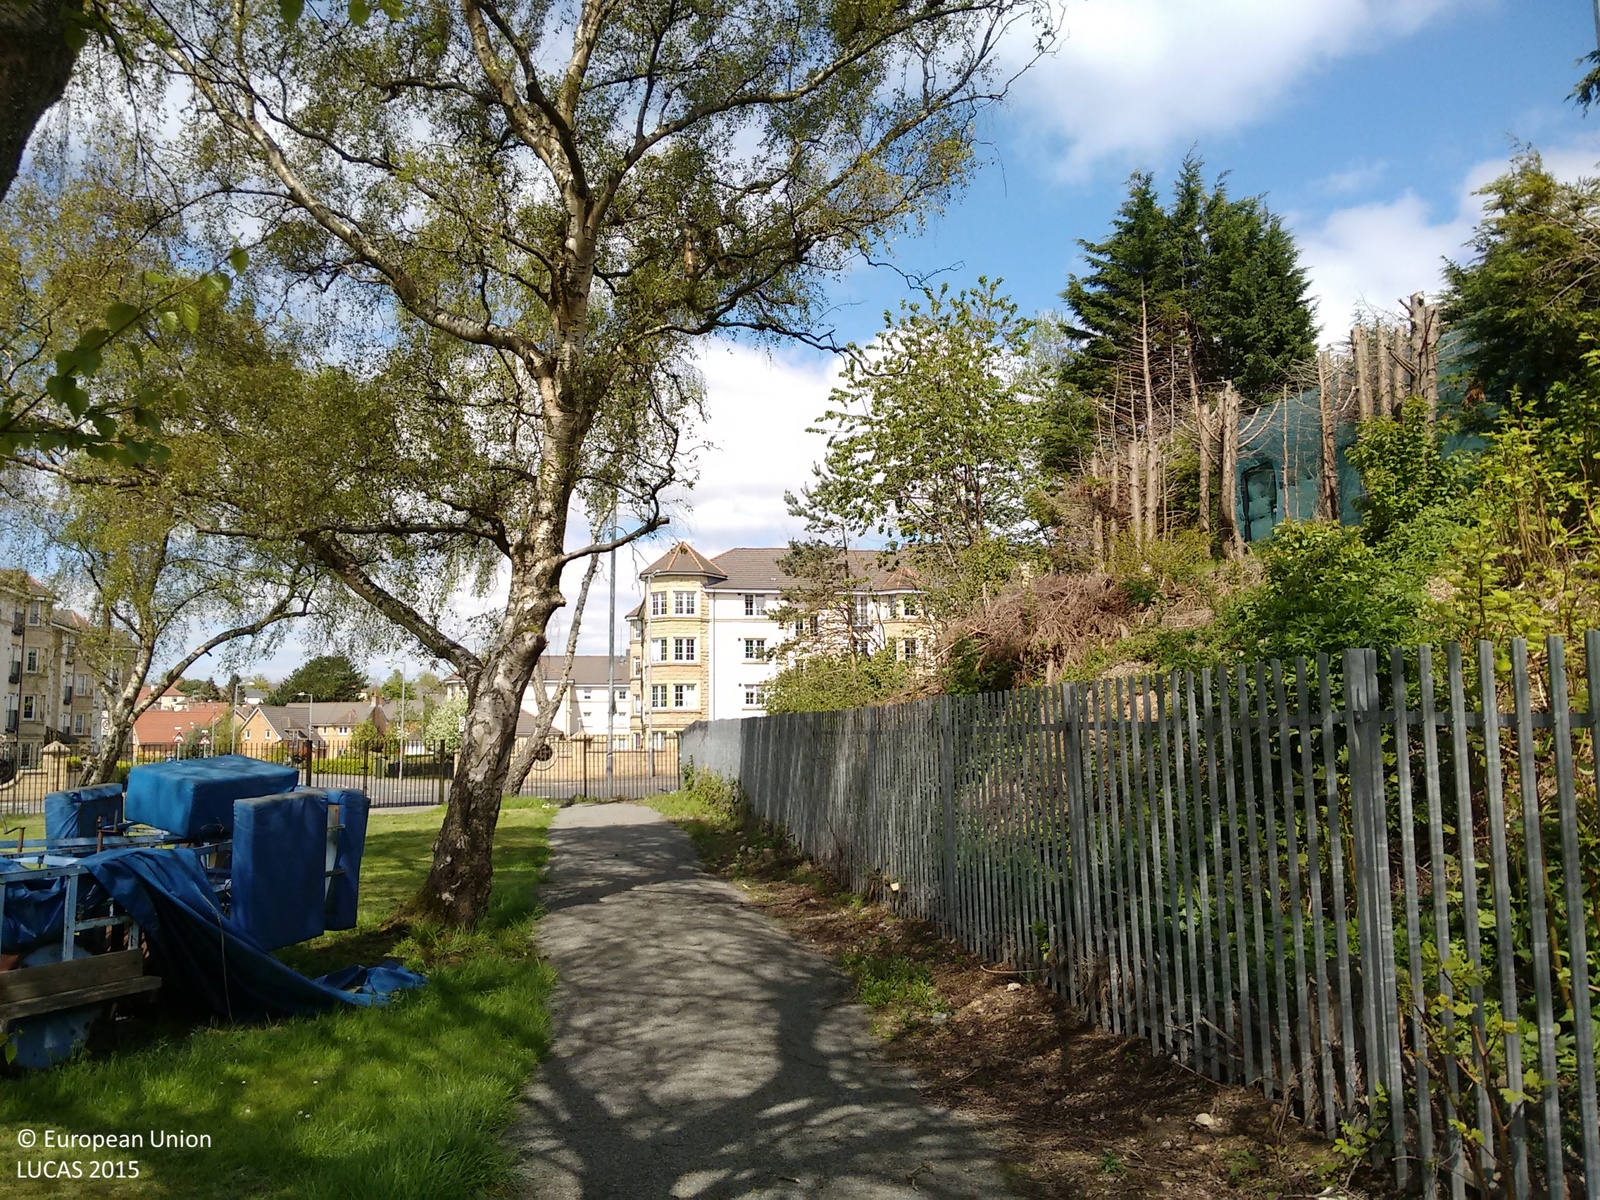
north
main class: Woodland
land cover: Broadleaved woodland
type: exotic forest
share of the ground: > 75 %
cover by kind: broadleaved forest trees 60 %, herbaceous plants 40 %
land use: Sport
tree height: > 5 m
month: May
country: GB
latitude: 55.8886
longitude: -4.3410
